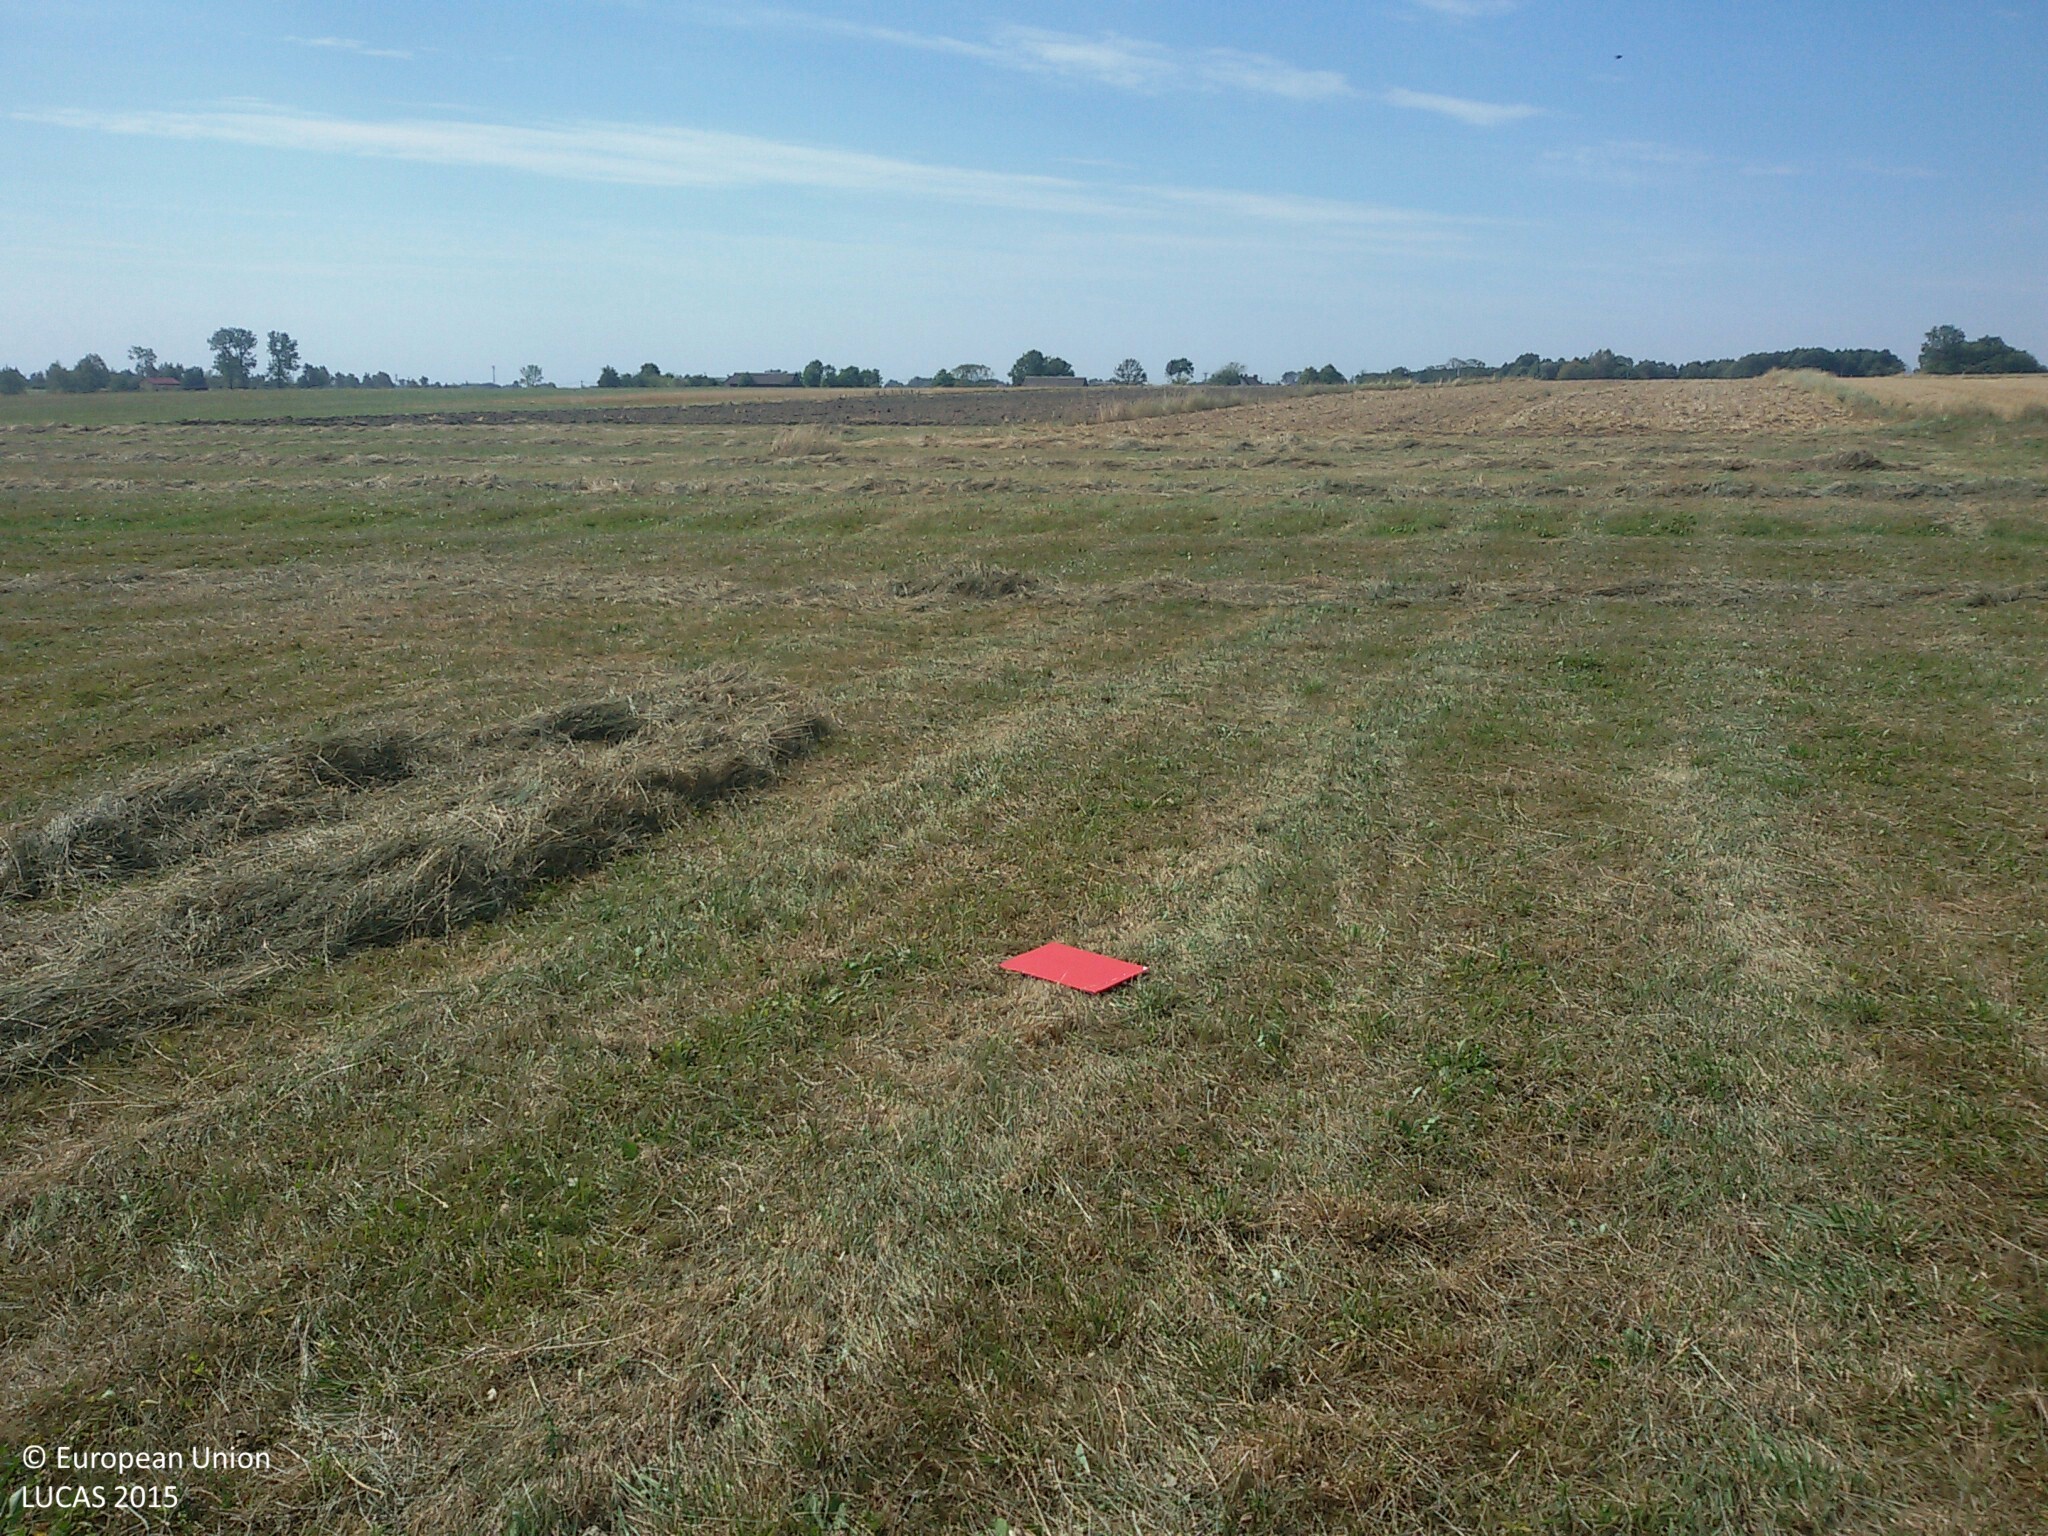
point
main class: Grassland
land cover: Grassland without tree/shrub cover
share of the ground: > 75 %
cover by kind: herbaceous plants 100 %
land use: Agriculture (excluding fallow land and kitchen gardens)
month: August
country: PL
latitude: 52.6739
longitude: 21.2728
